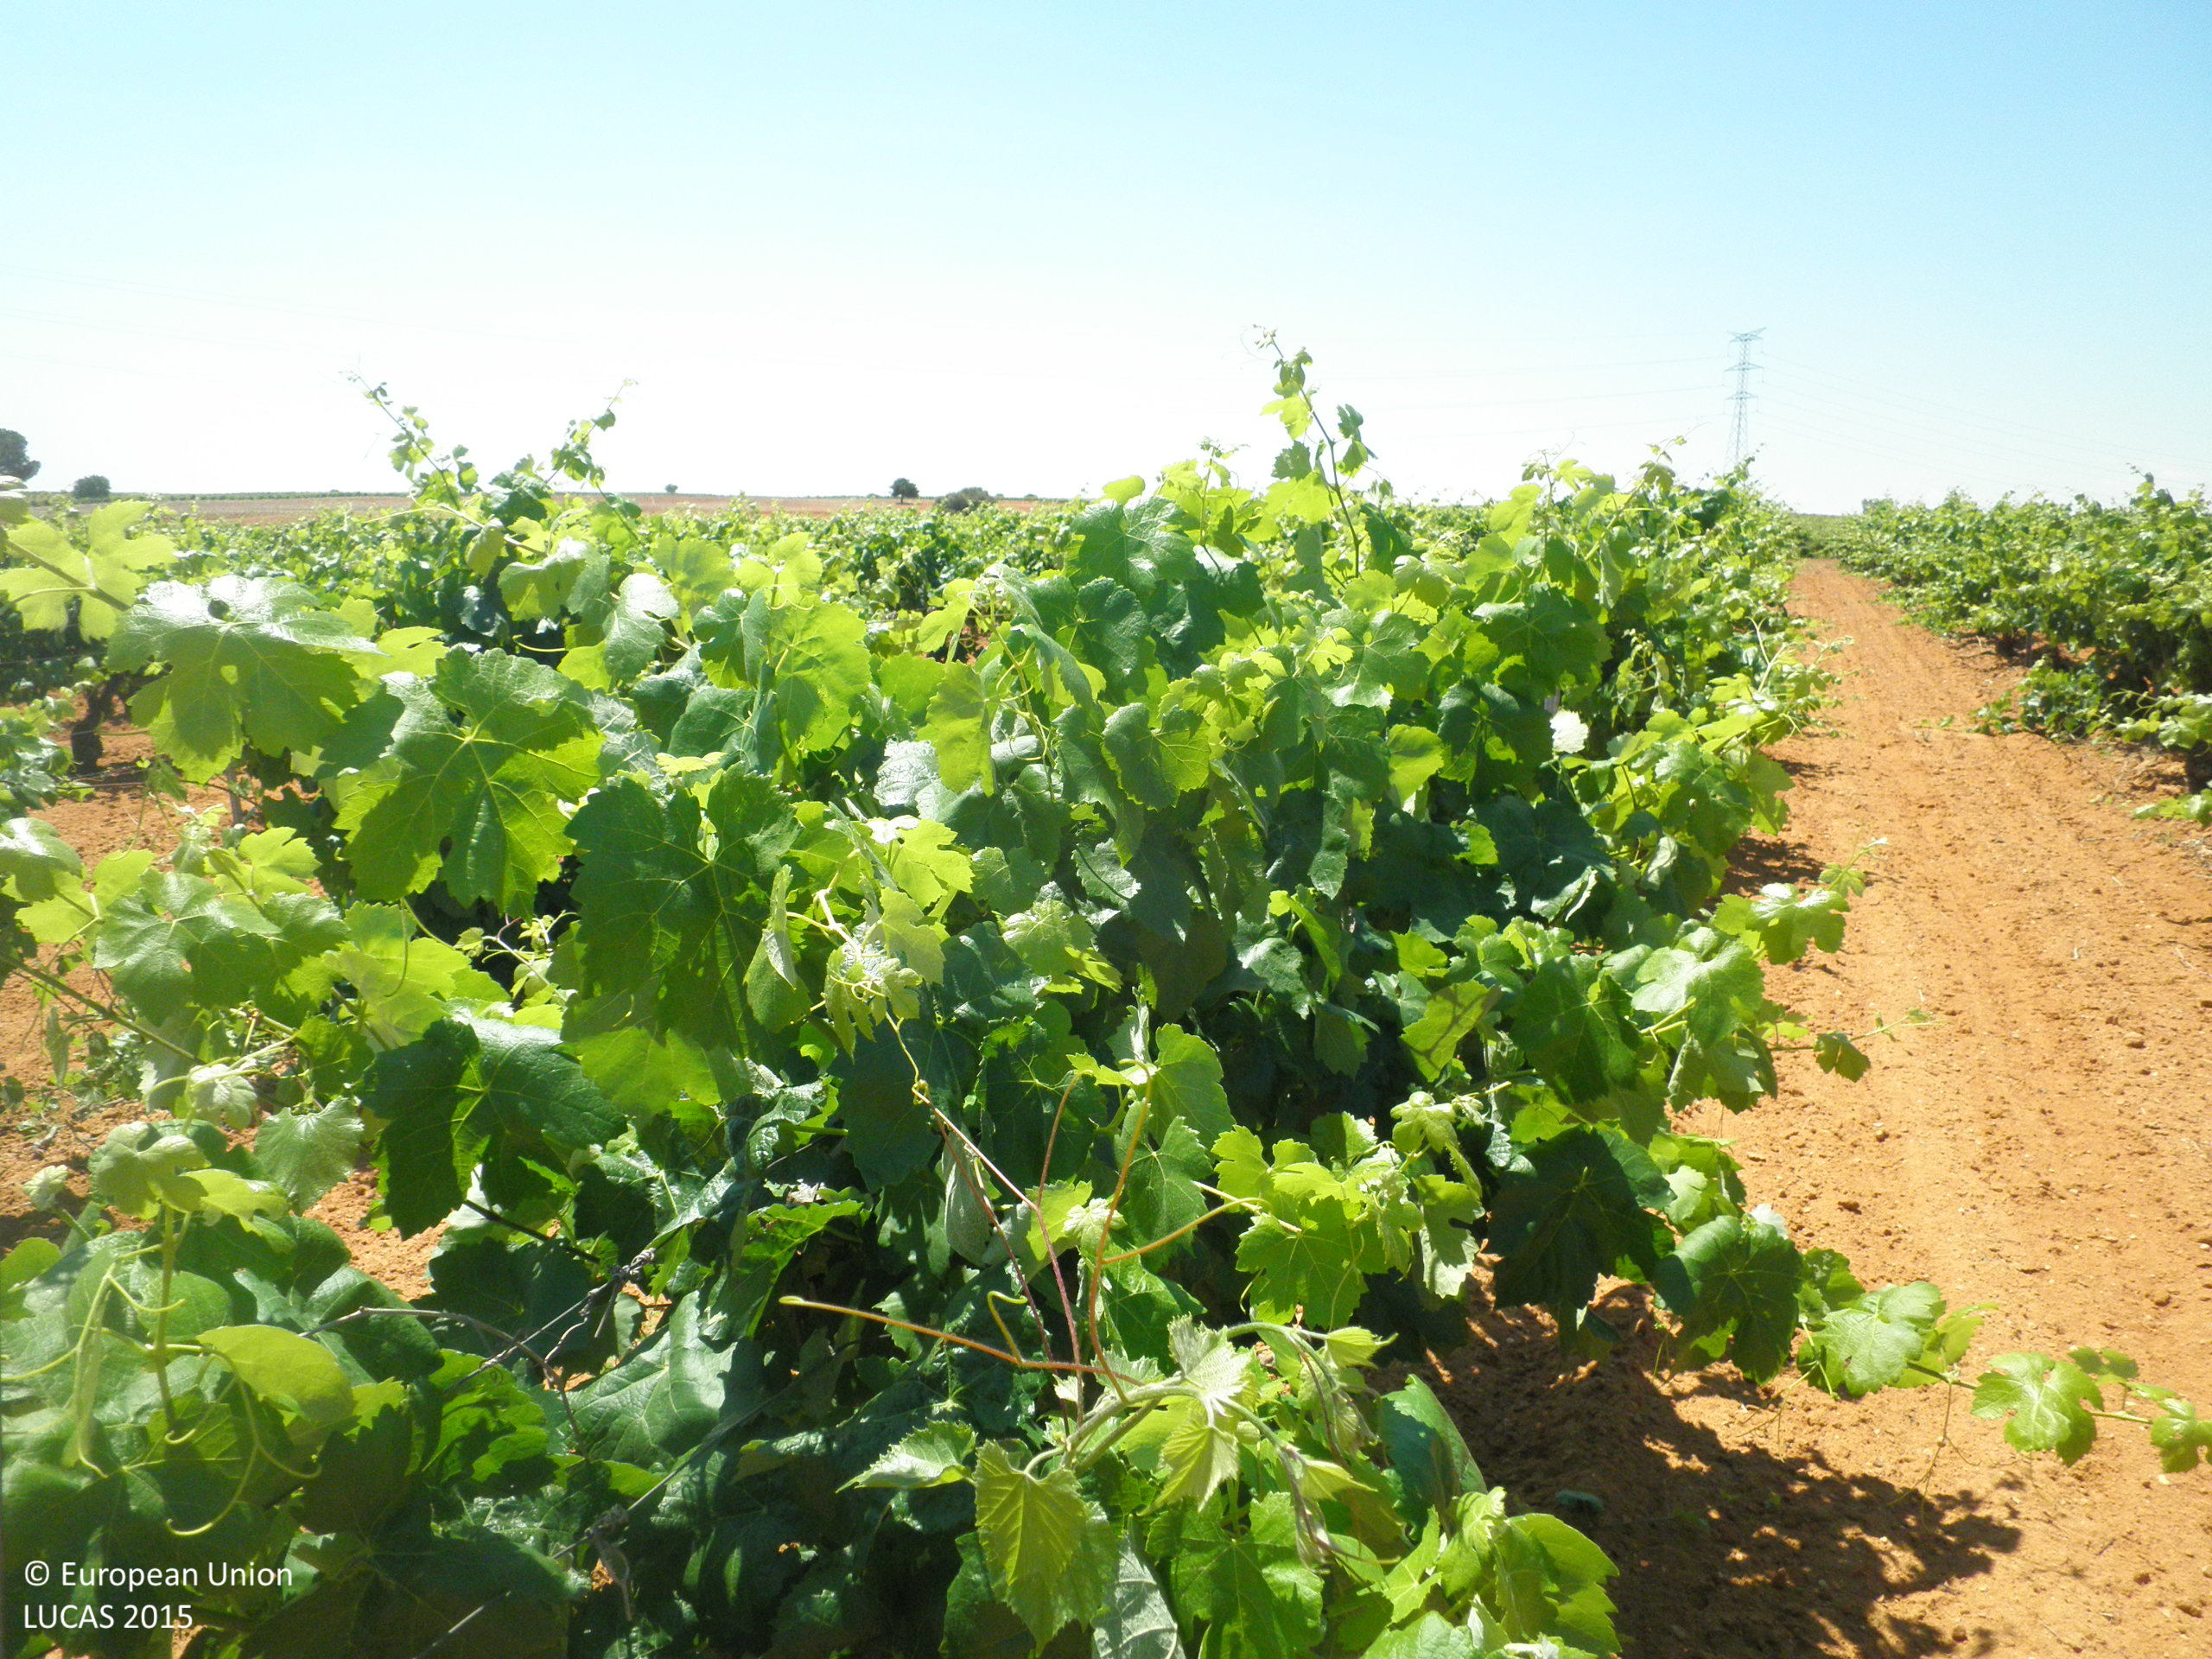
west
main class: Cropland
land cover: Vineyards
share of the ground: 10 - 25 %
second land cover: Other bare soil
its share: > 75 %
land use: Agriculture (excluding fallow land and kitchen gardens)
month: June
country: ES
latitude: 39.3659
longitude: -1.8320
